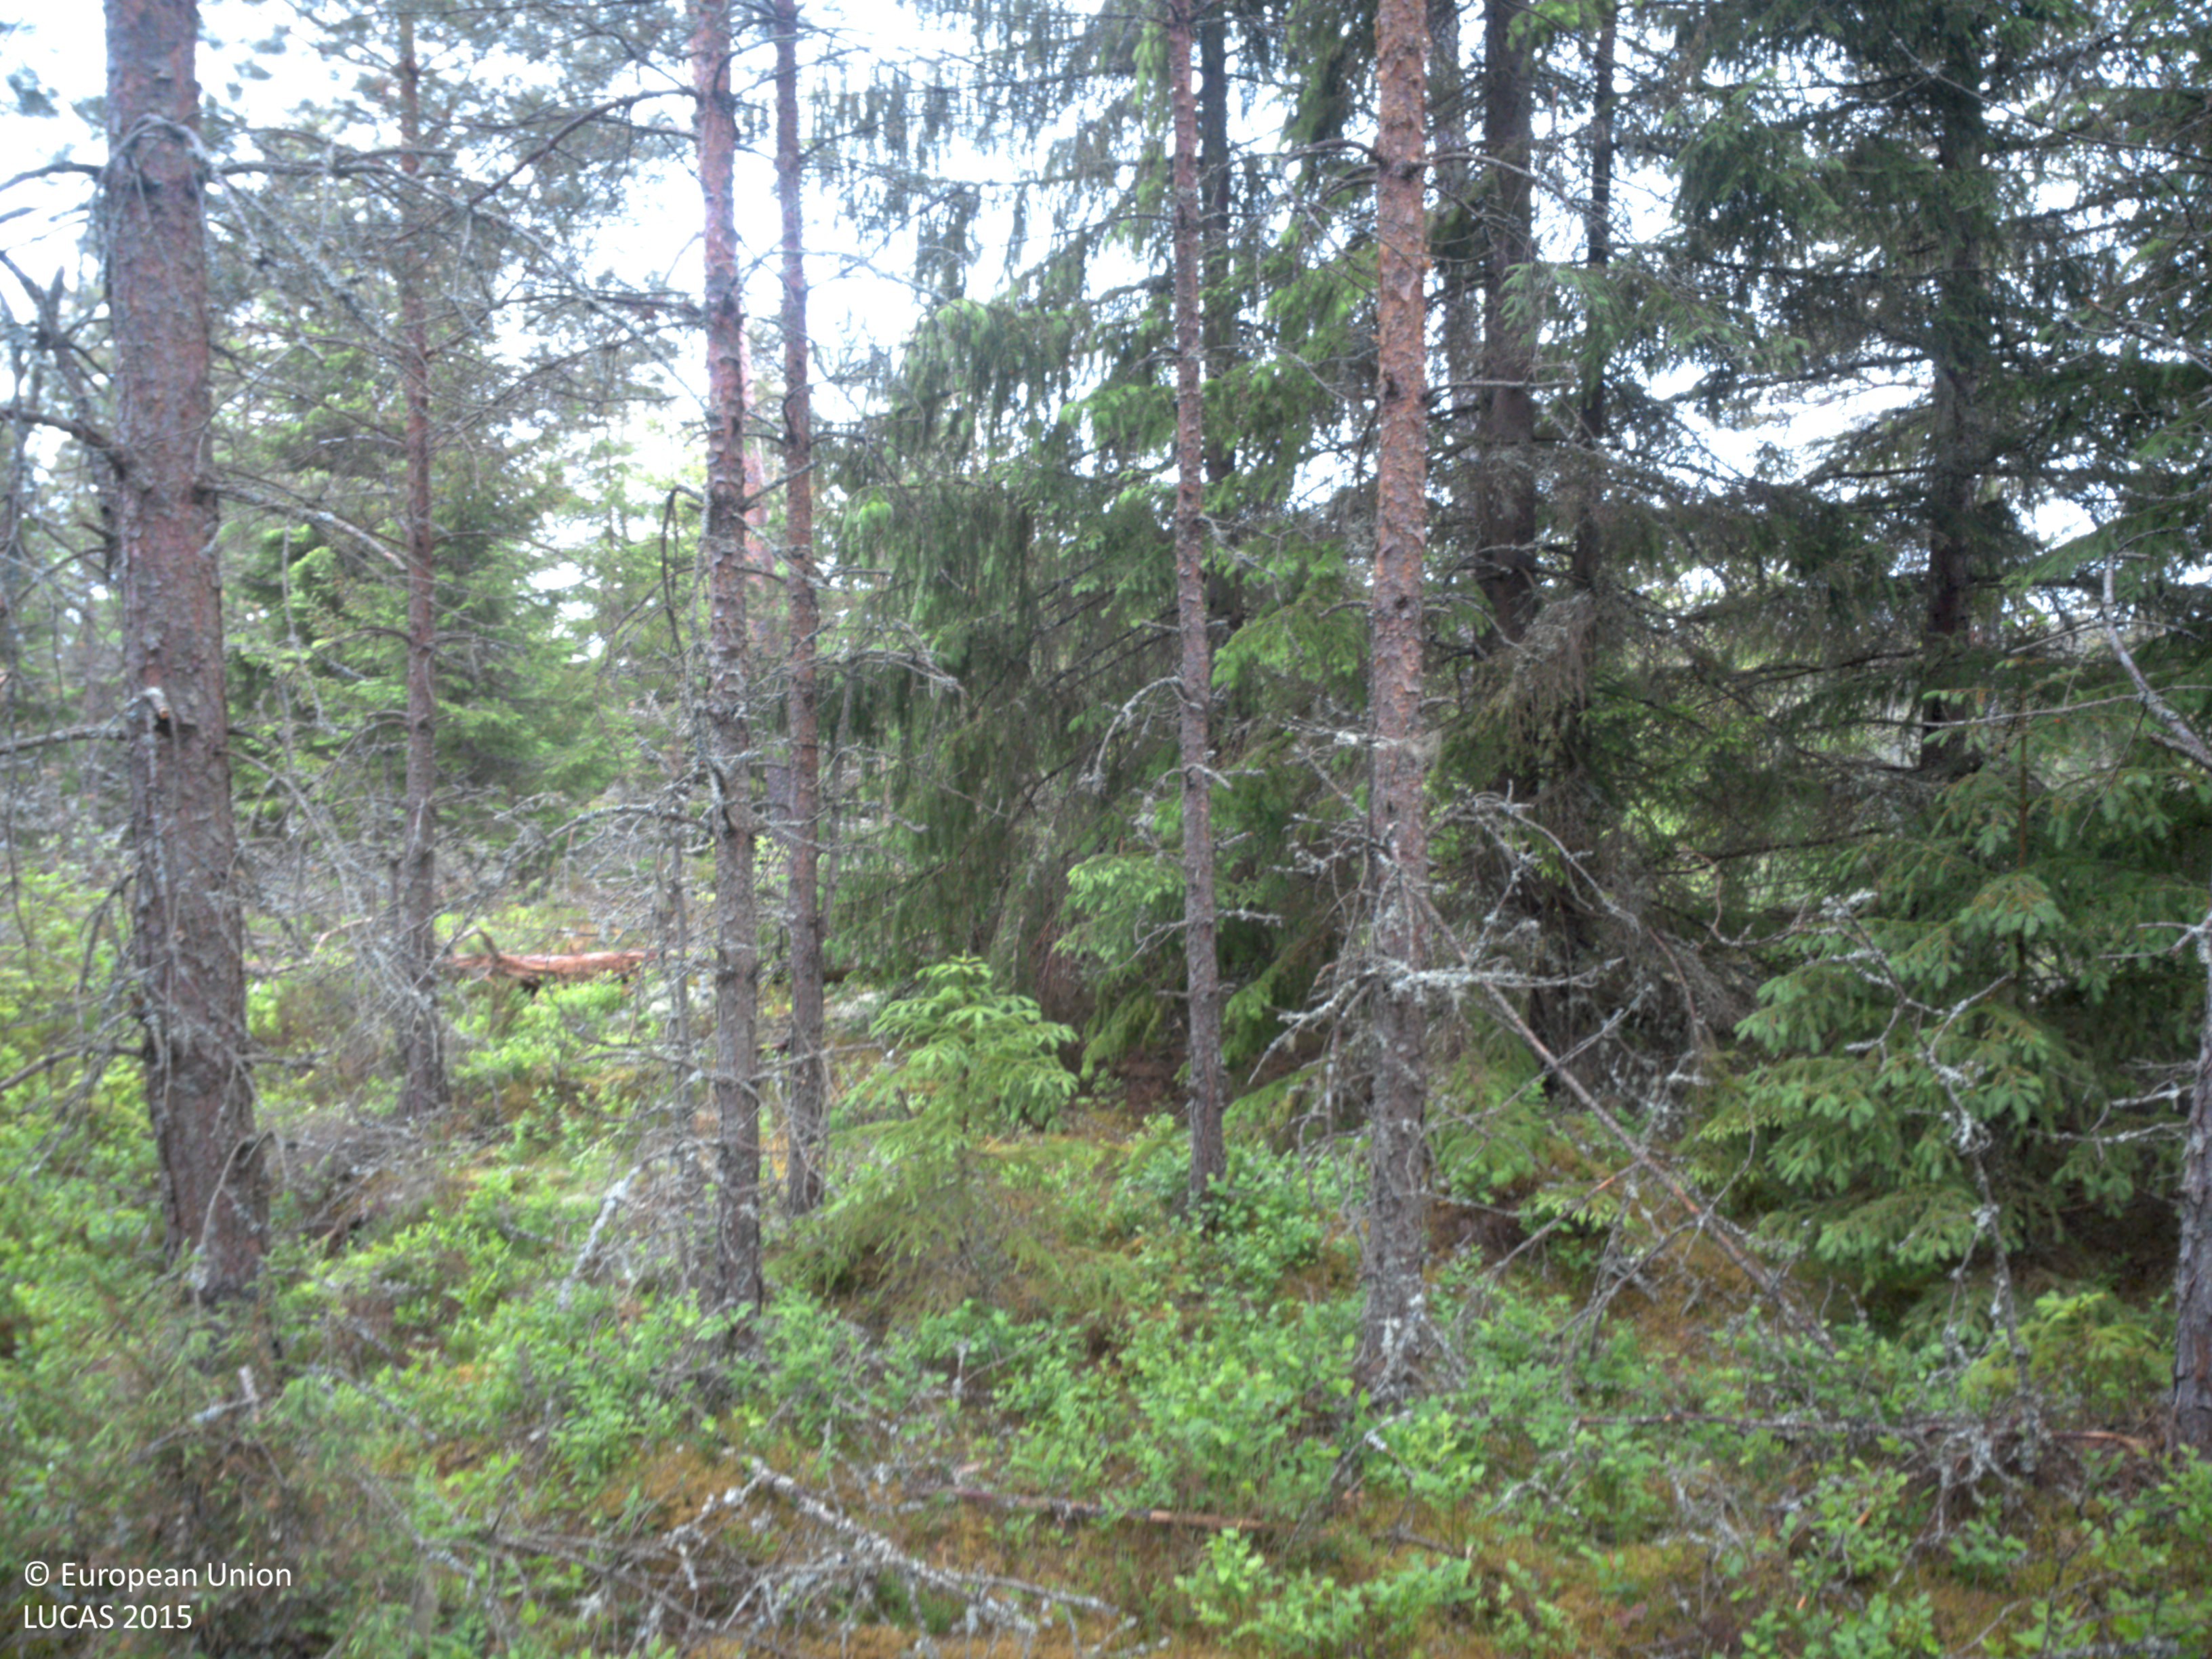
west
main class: Woodland
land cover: Pine dominated coniferous woodland
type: boreal forest
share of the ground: 50 - 75 %
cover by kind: coniferous forest trees 50 %, lichens and mosses 30 %, shrubs 20 %
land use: Forestry
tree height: > 5 m
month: June
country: SE
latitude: 59.1038
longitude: 12.0379
